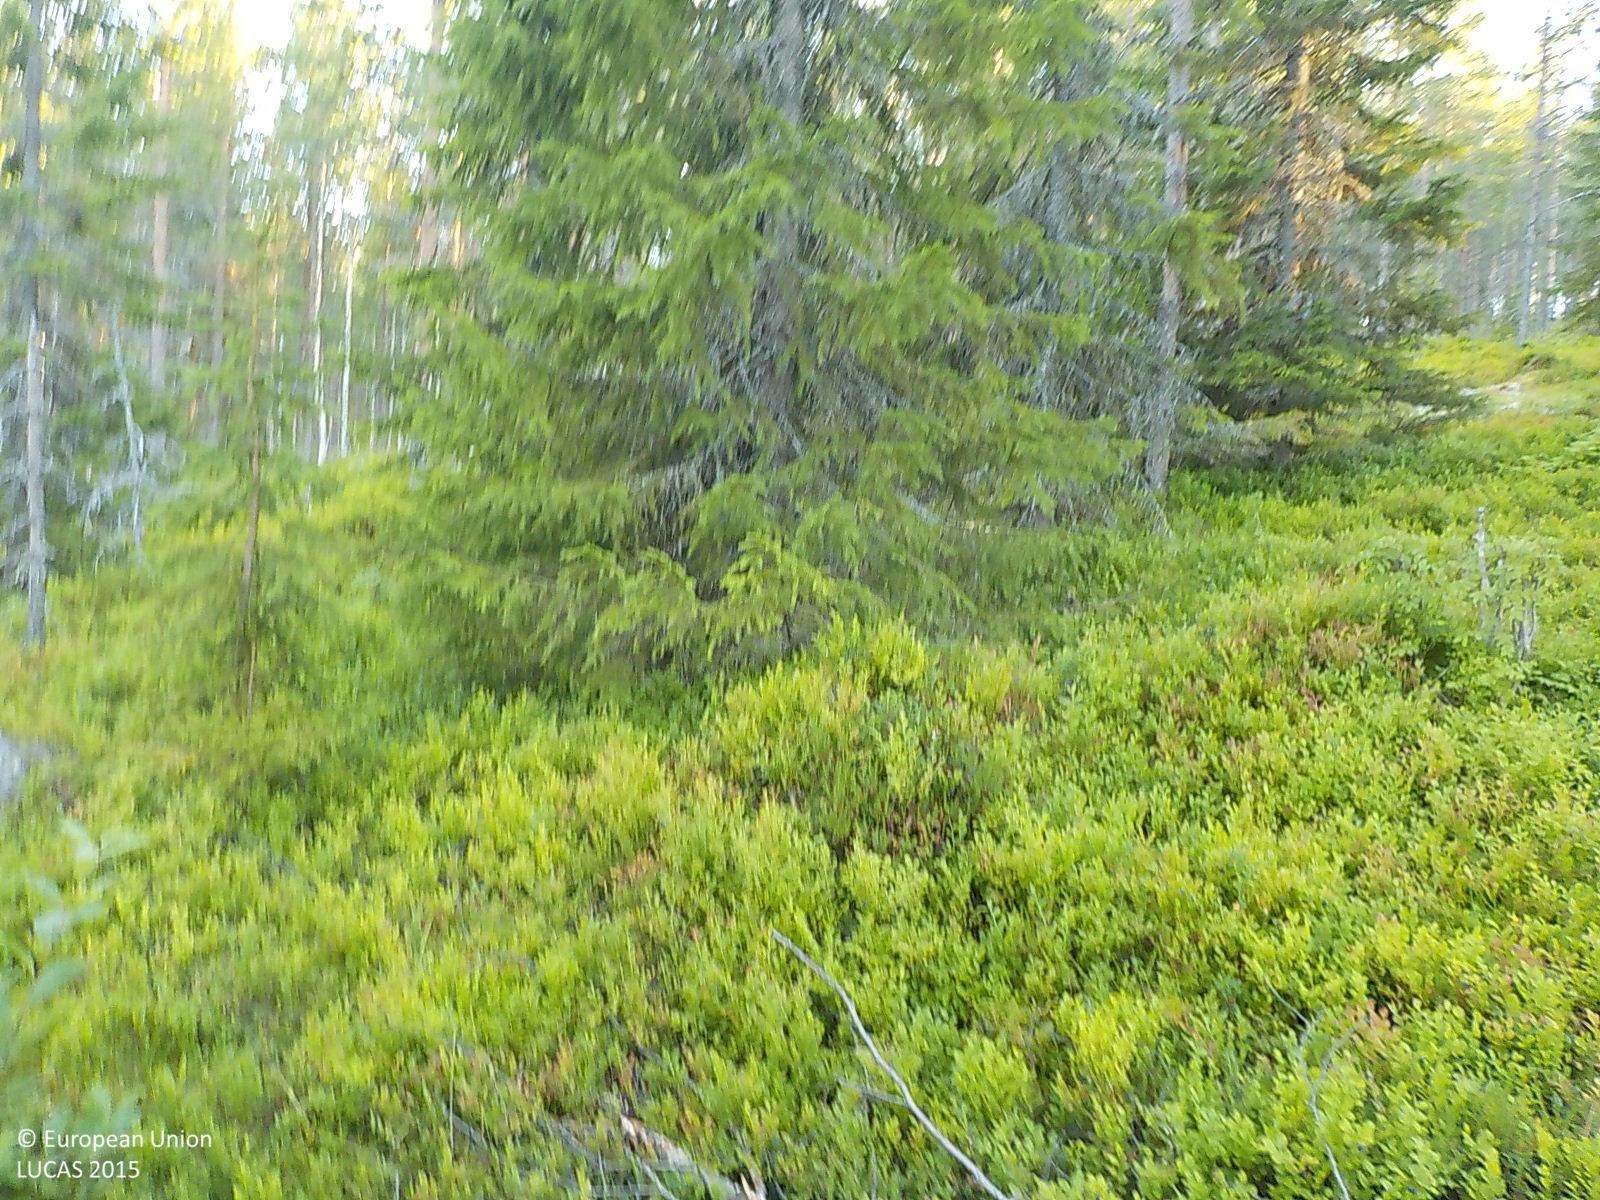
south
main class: Woodland
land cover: Pine dominated coniferous woodland
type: boreal forest
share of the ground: 50 - 75 %
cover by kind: coniferous forest trees 50 %, shrubs 30 %, herbaceous plants 10 %, lichens and mosses 10 %
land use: Forestry
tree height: > 5 m
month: August
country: SE
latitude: 63.4703
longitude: 18.6658
